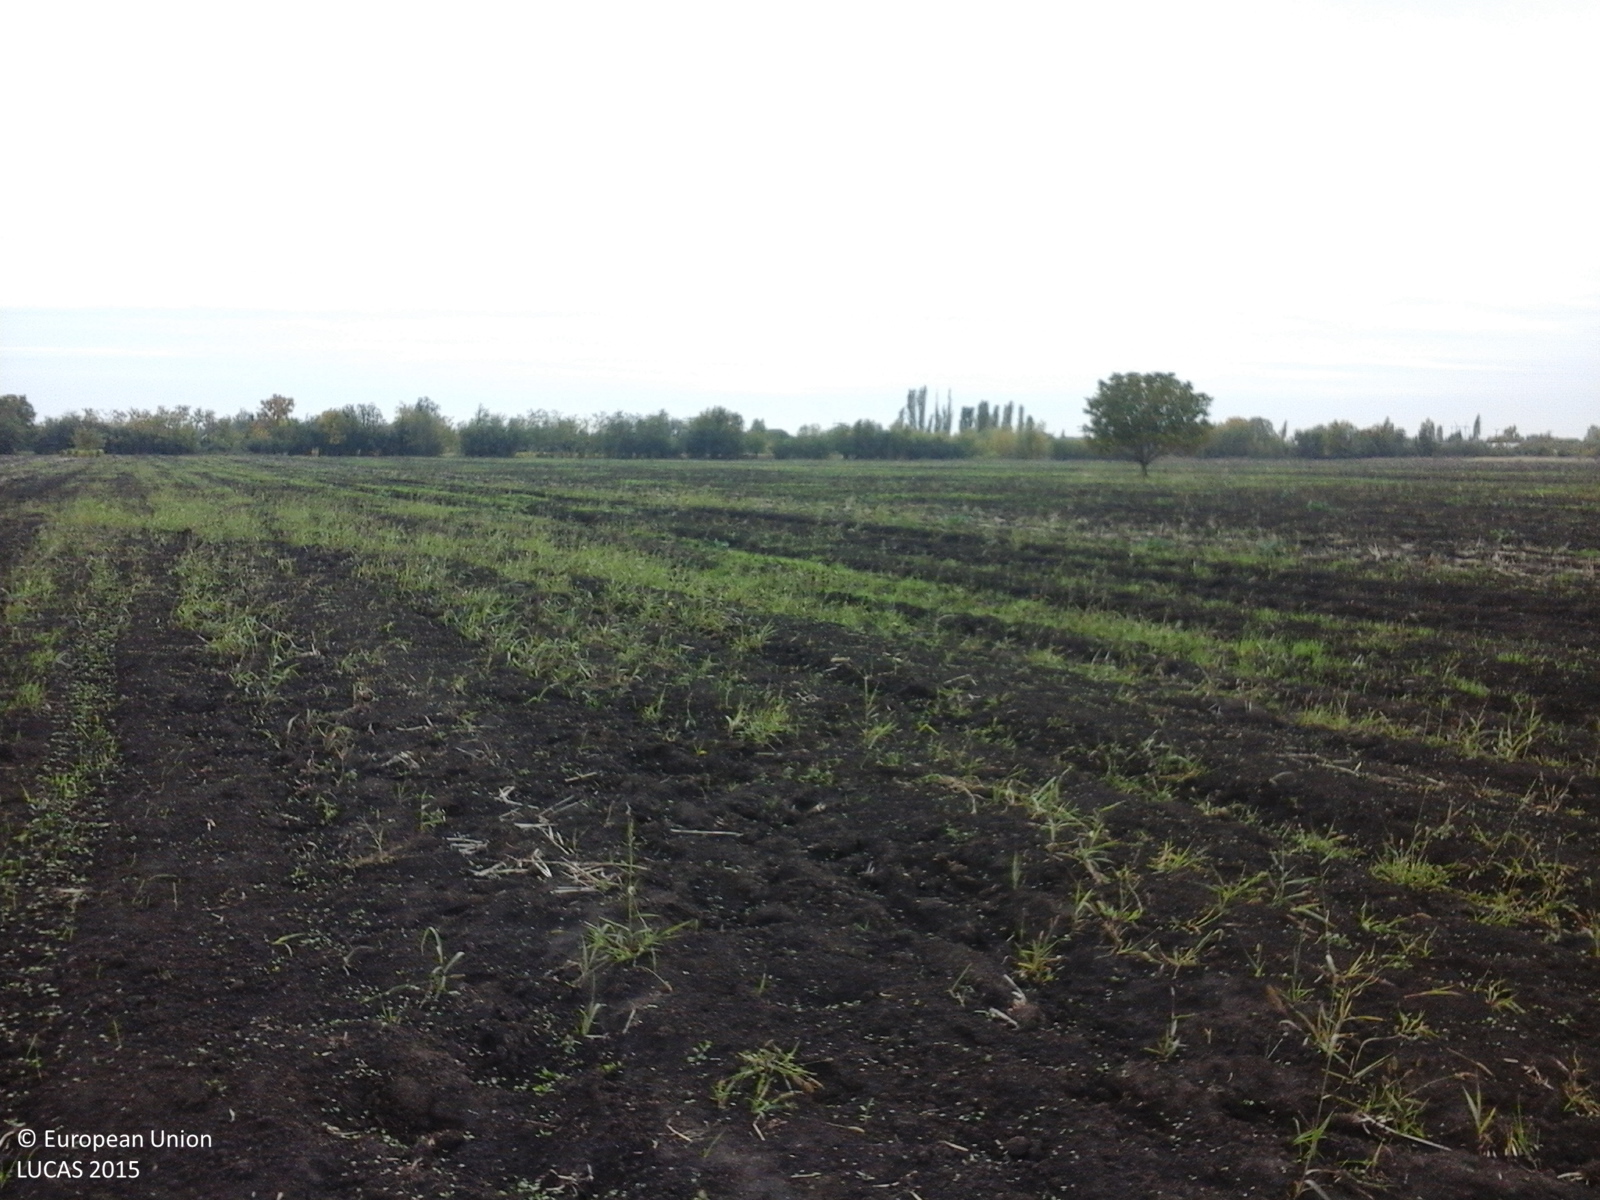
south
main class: Cropland
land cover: Common wheat
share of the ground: < 10 %
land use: Agriculture (excluding fallow land and kitchen gardens)
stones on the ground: < 10 %
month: October
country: RO
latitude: 44.9706
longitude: 26.3591
